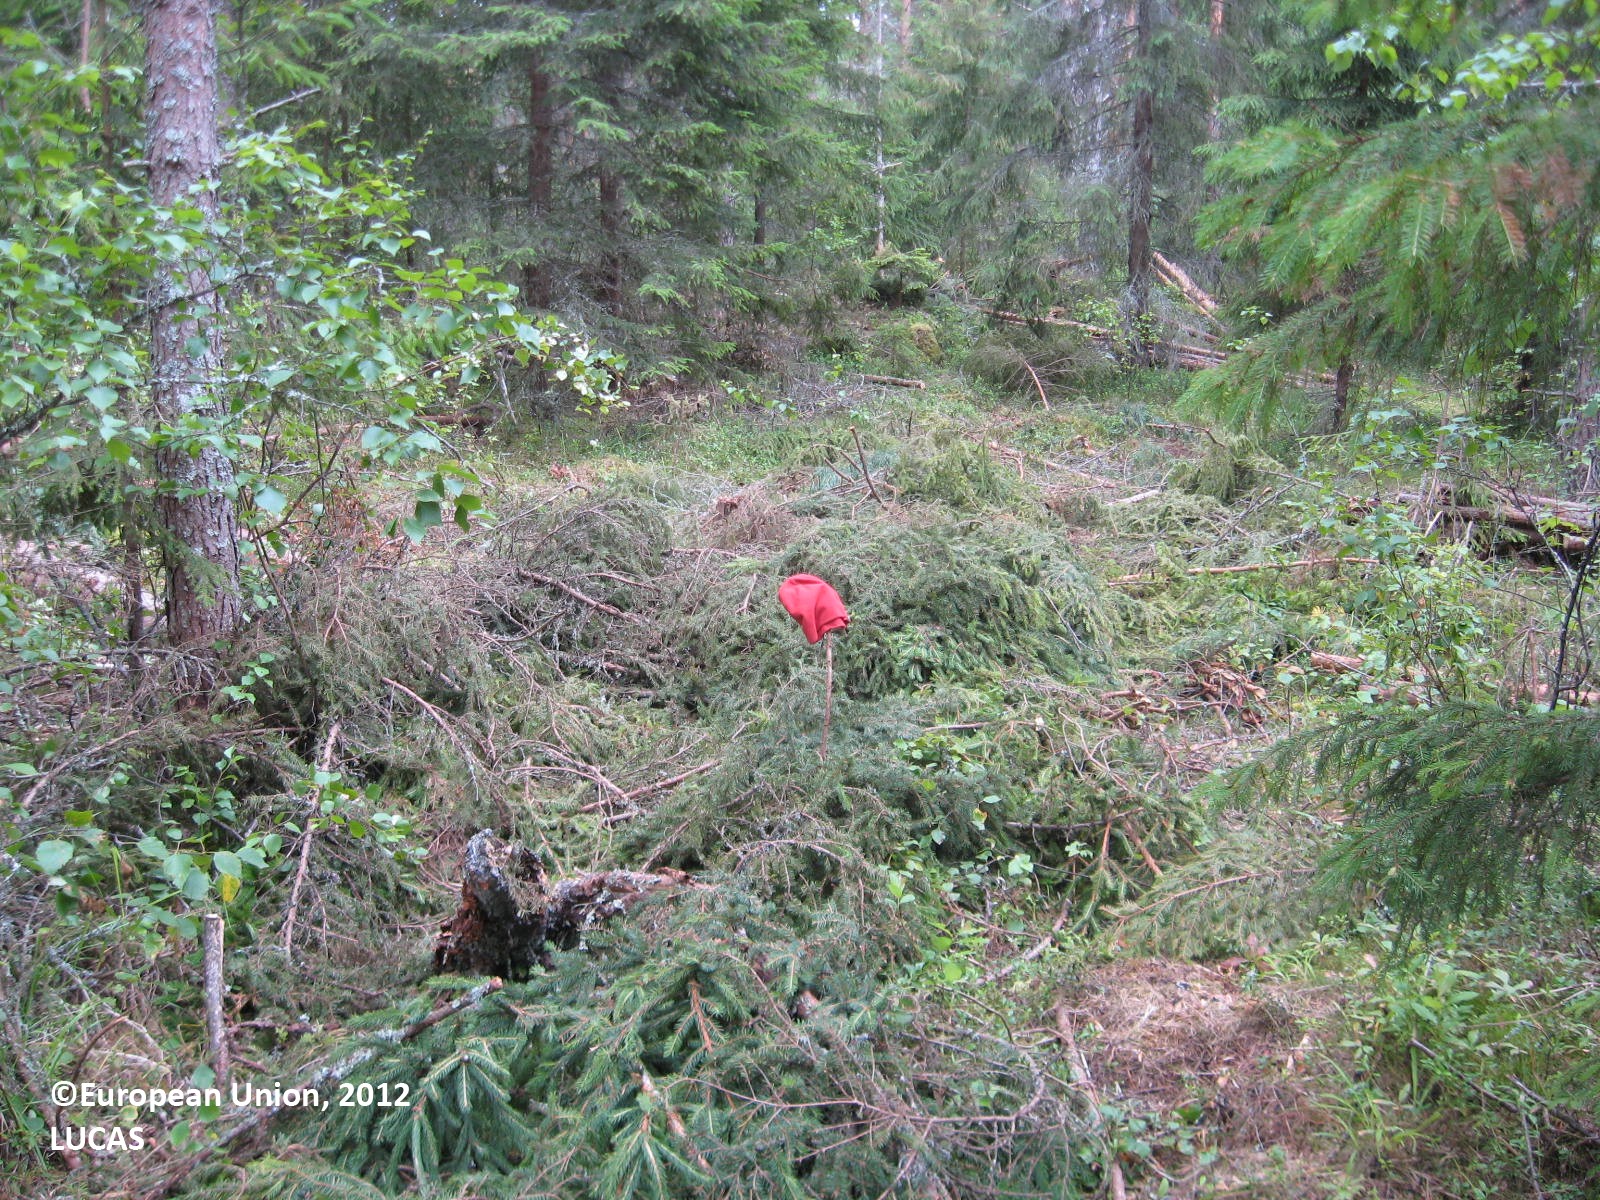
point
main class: Woodland
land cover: Other coniferous woodland
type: boreal forest
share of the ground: > 75 %
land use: Forestry
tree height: > 5 m
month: July
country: FI
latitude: 61.9155
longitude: 21.4912
